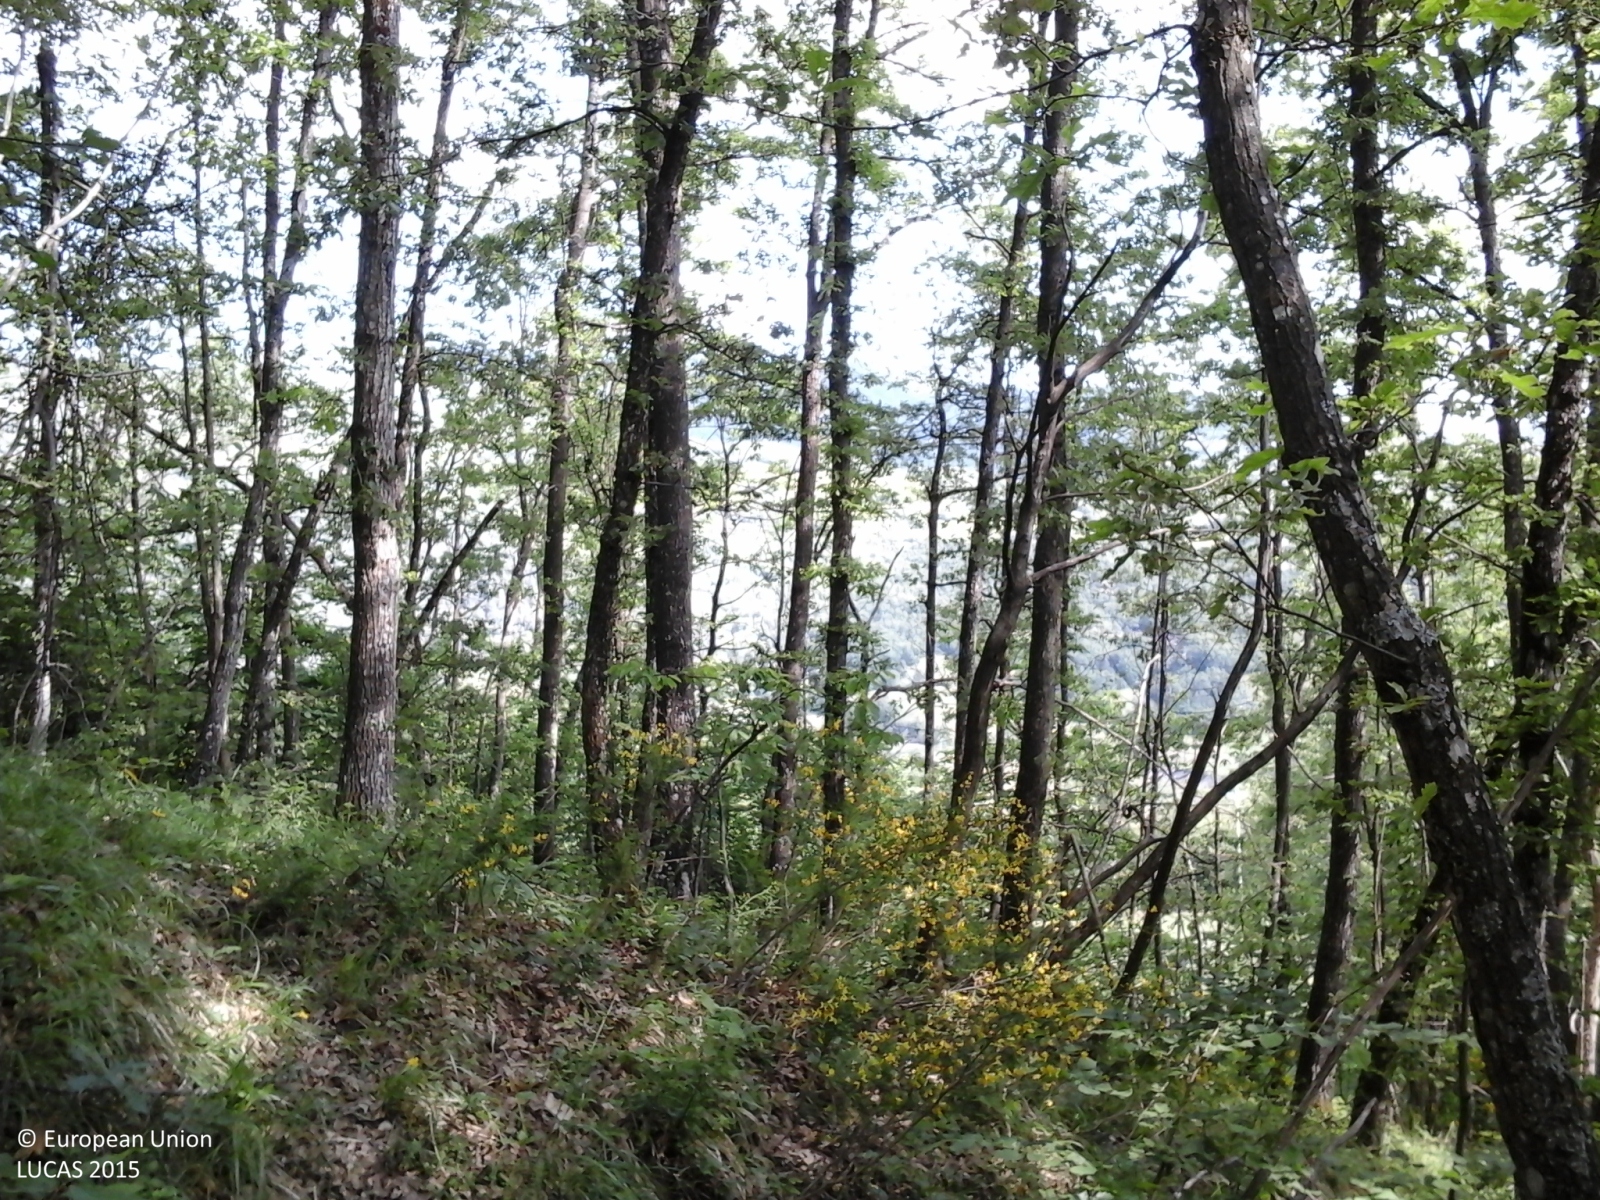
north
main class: Woodland
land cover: Broadleaved woodland
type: thermophilous deciduous forest
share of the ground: > 75 %
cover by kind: broadleaved forest trees 95 %, shrubs 5 %
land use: Forestry
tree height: > 5 m
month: May
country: IT
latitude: 44.5128
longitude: 10.1130
